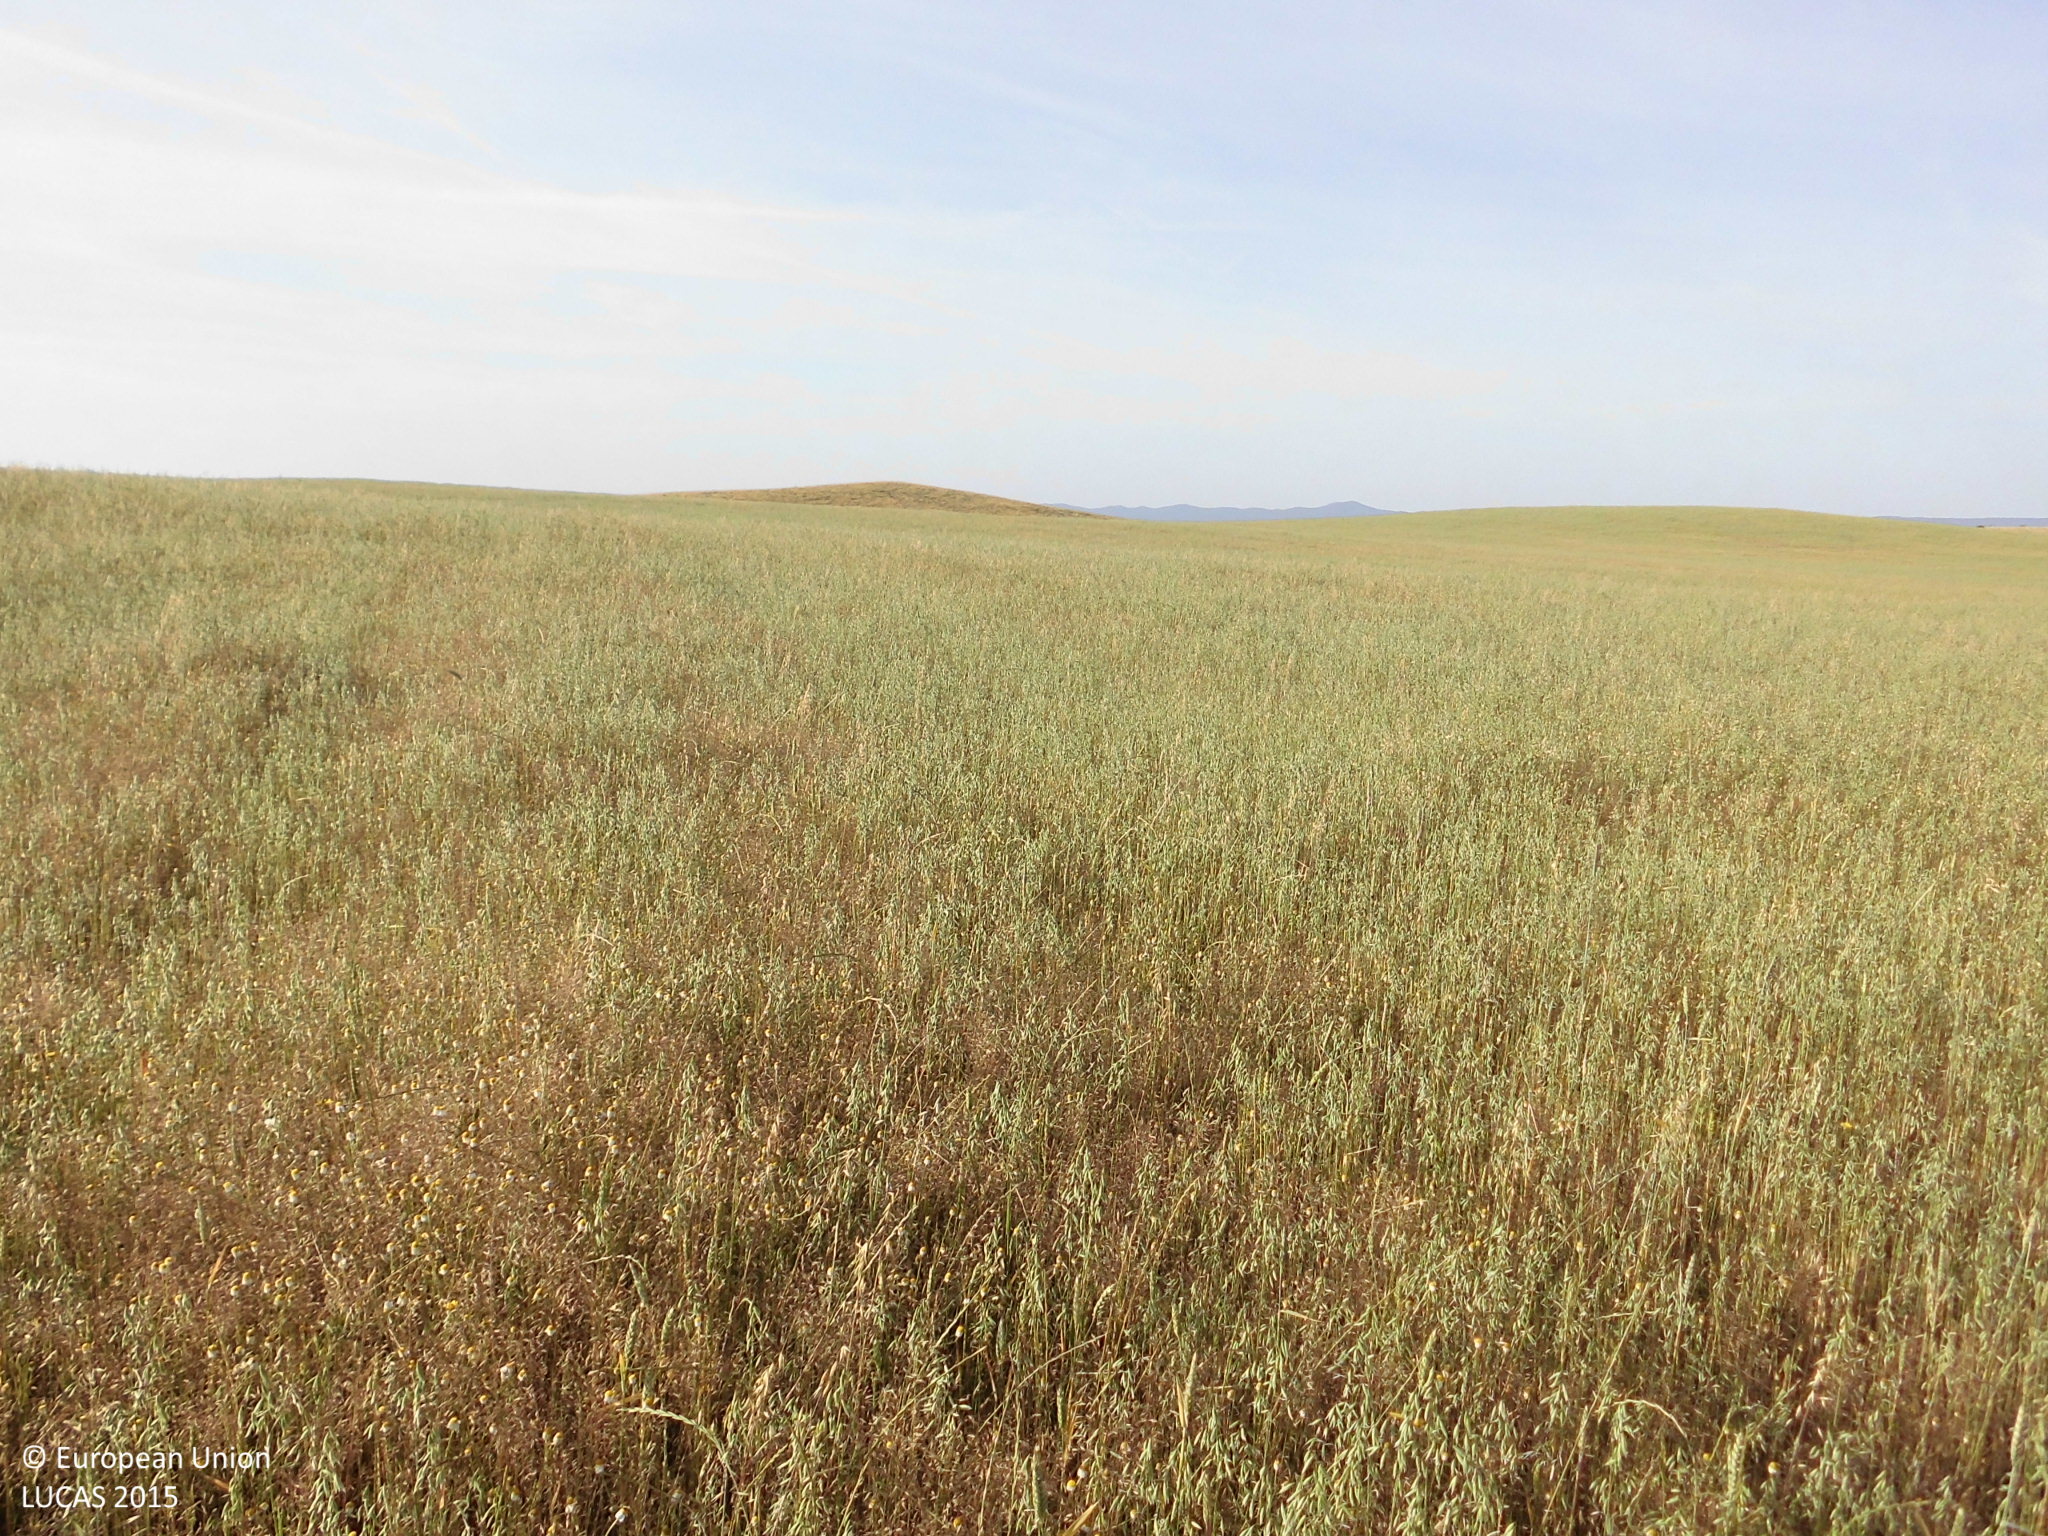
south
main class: Cropland
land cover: Oats
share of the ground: > 75 %
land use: Agriculture (excluding fallow land and kitchen gardens)
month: May
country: ES
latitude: 39.6084
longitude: -6.9593
